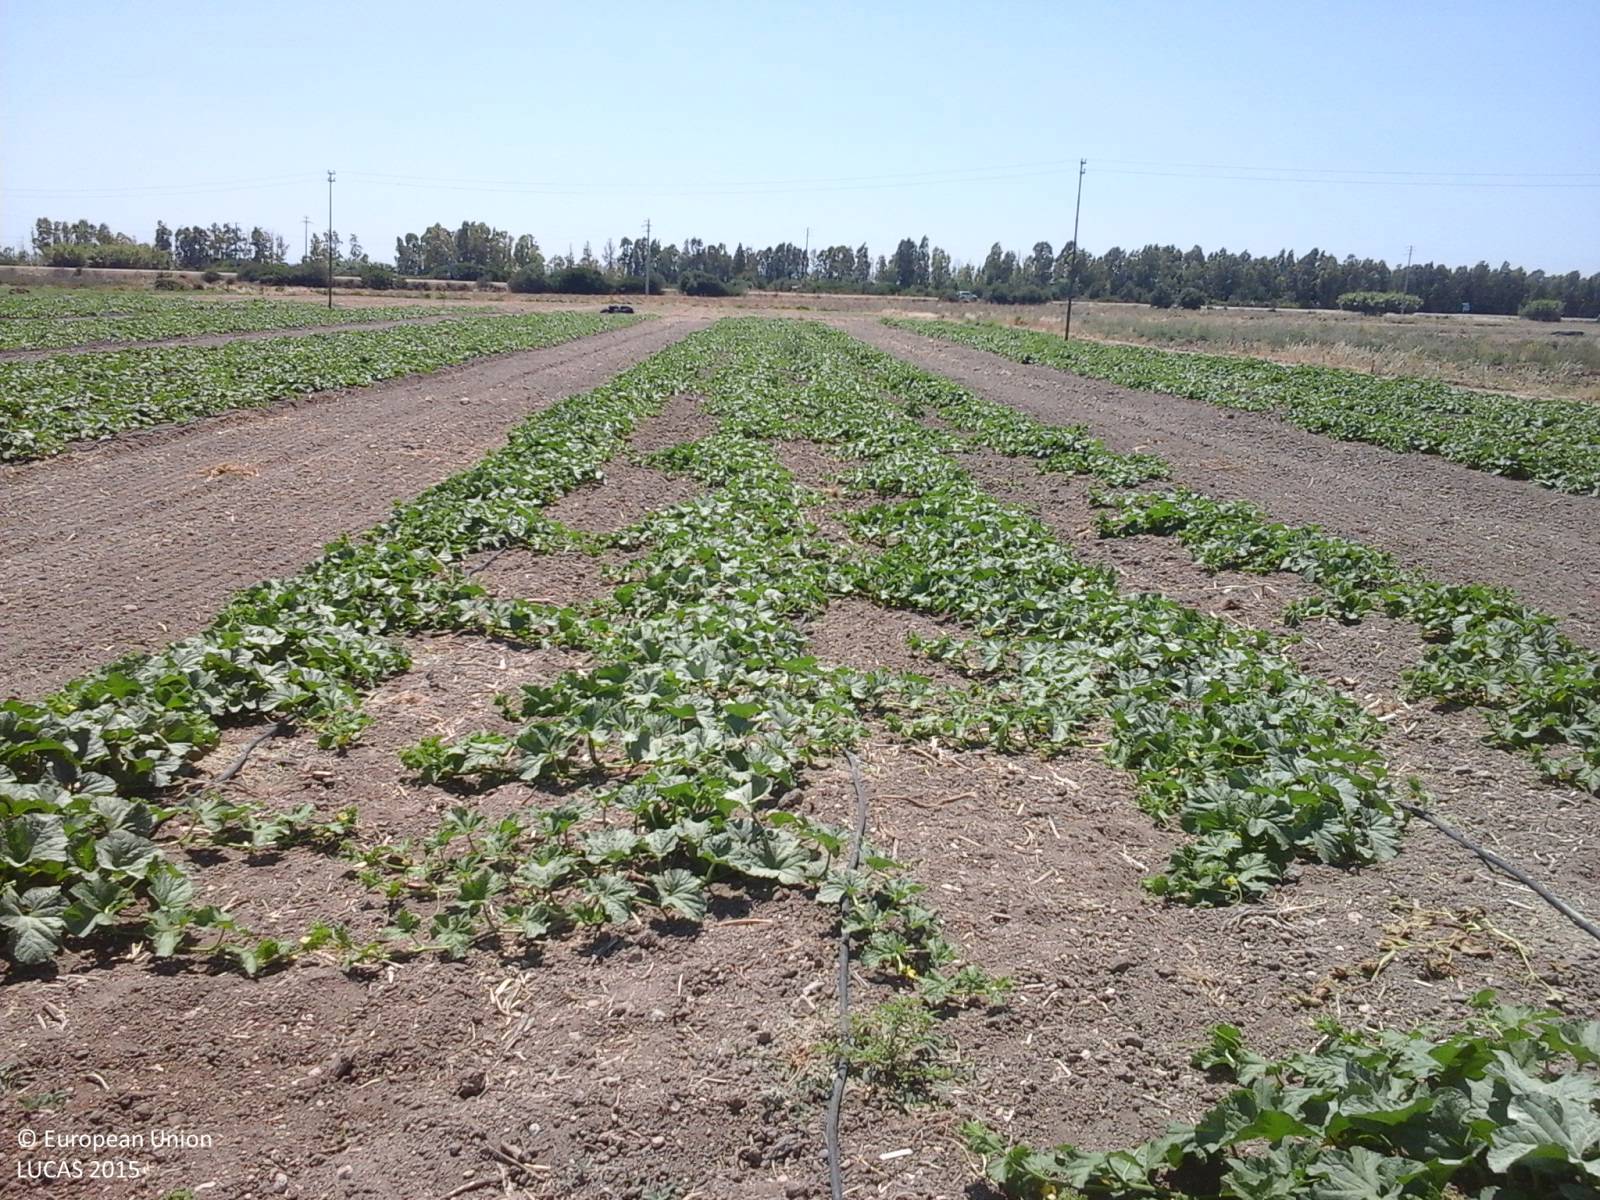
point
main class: Cropland
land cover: Other fresh vegetables
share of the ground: > 75 %
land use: Agriculture (excluding fallow land and kitchen gardens)
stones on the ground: 25 - 50 %
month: June
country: IT
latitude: 39.0611
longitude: 8.5645
